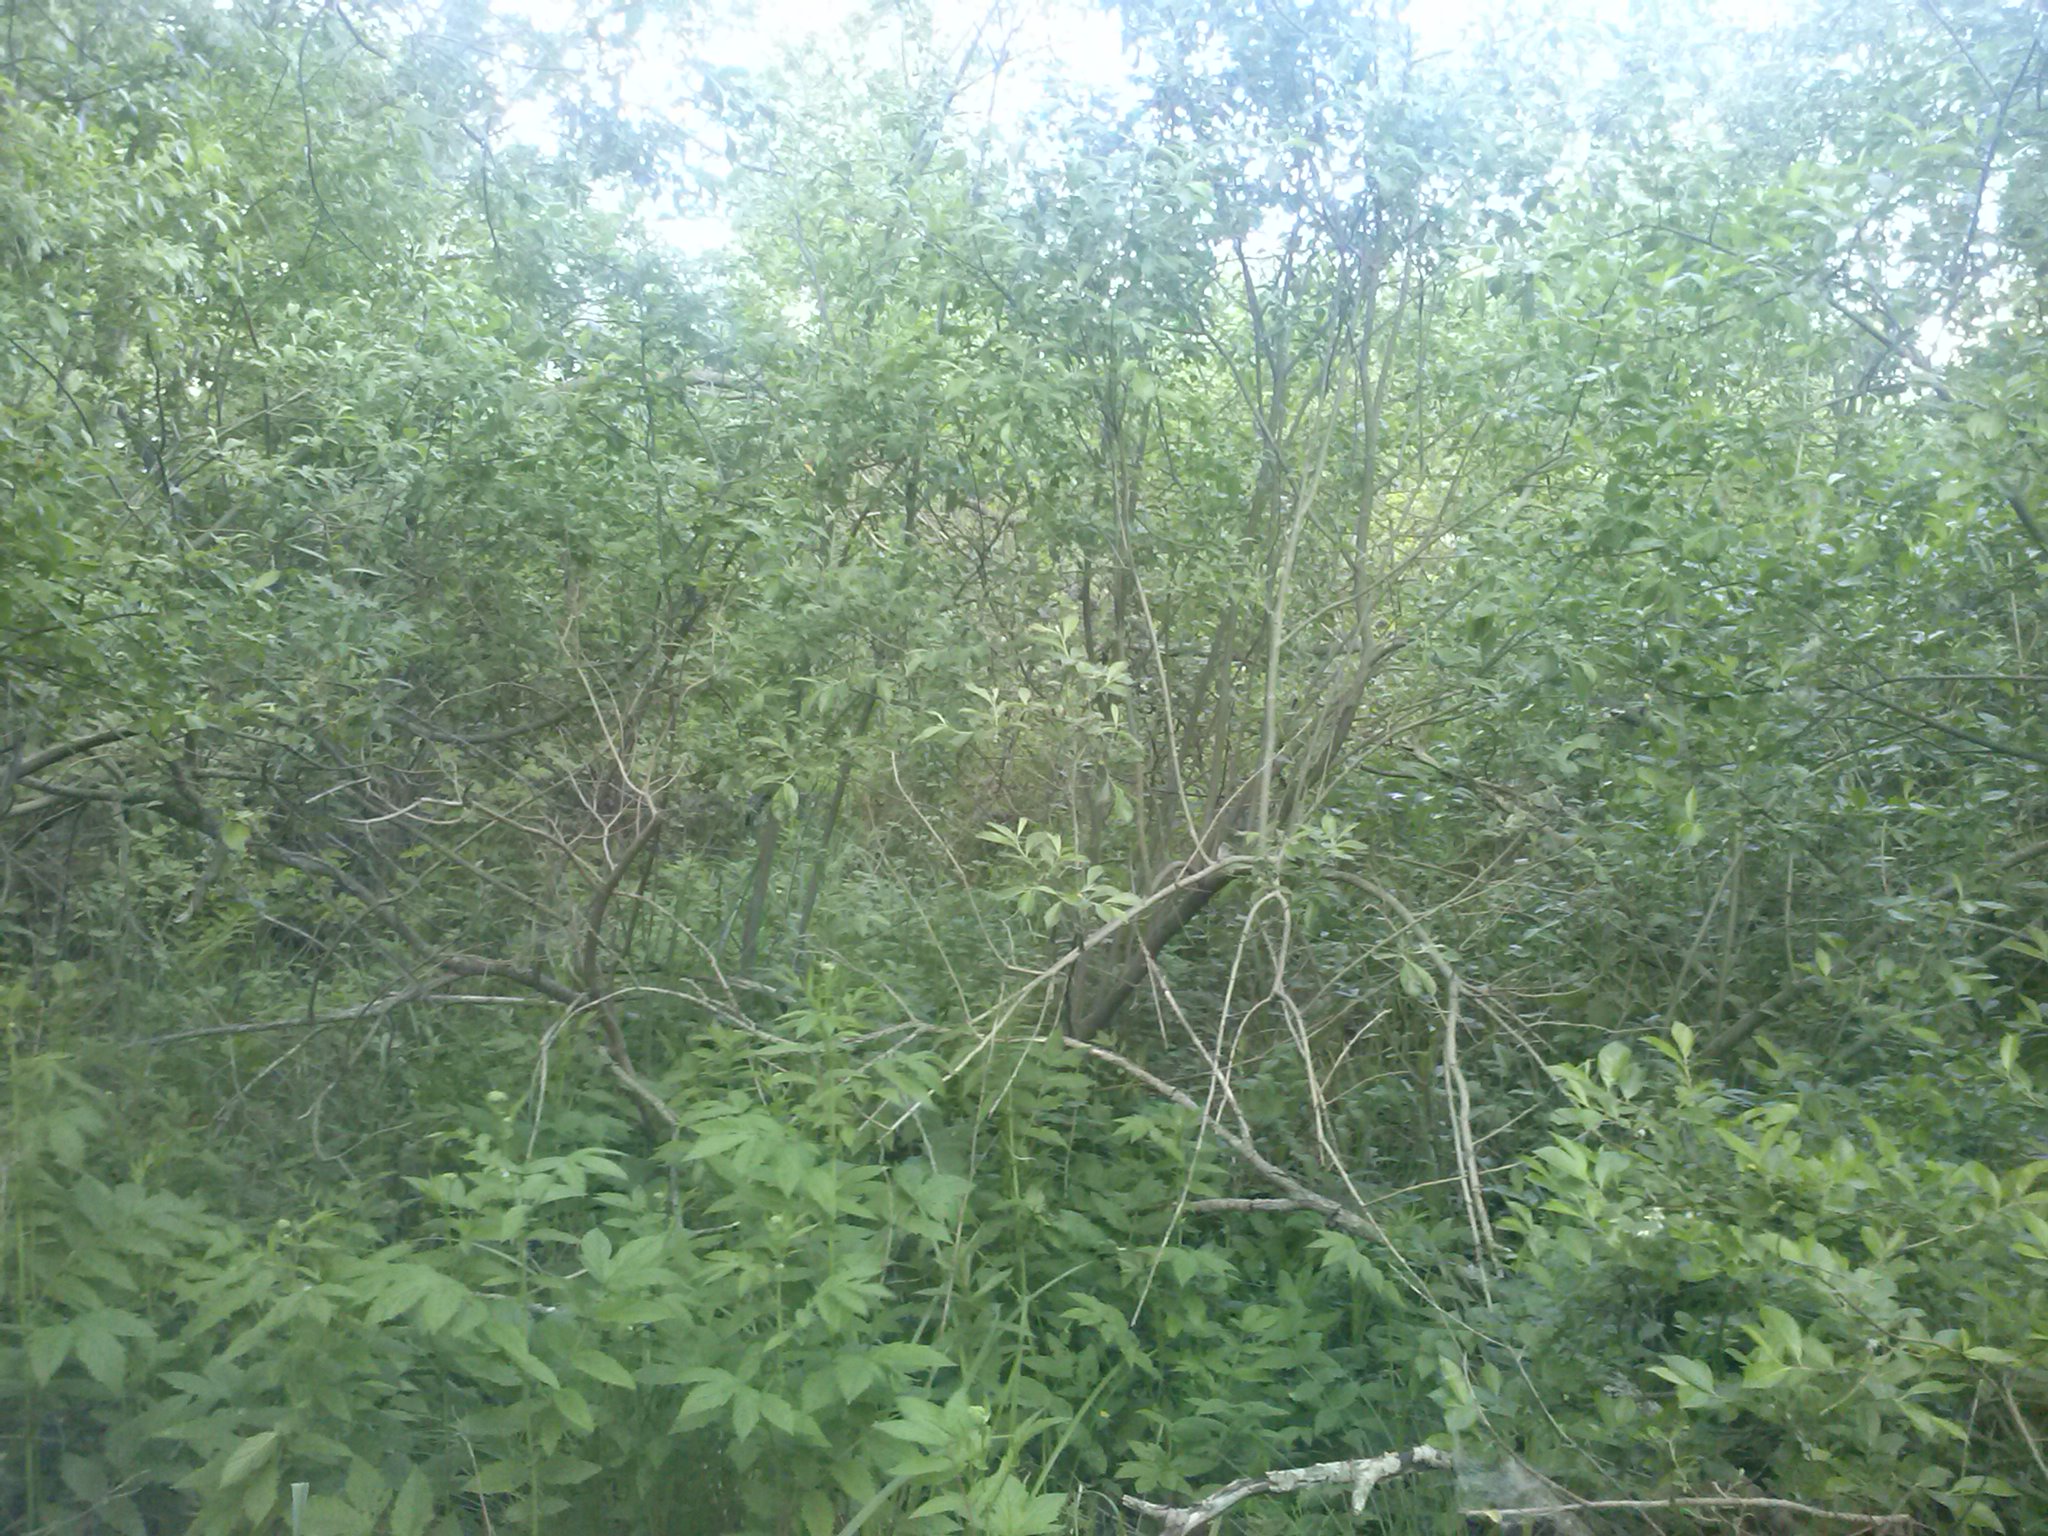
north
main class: Woodland
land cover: Broadleaved woodland
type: non-riverine alder, birch or aspen forest
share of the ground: > 75 %
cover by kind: broadleaved forest trees 90 %, herbaceous plants 10 %
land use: Forestry
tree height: > 5 m
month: June
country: LV
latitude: 56.3444
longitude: 27.5751
